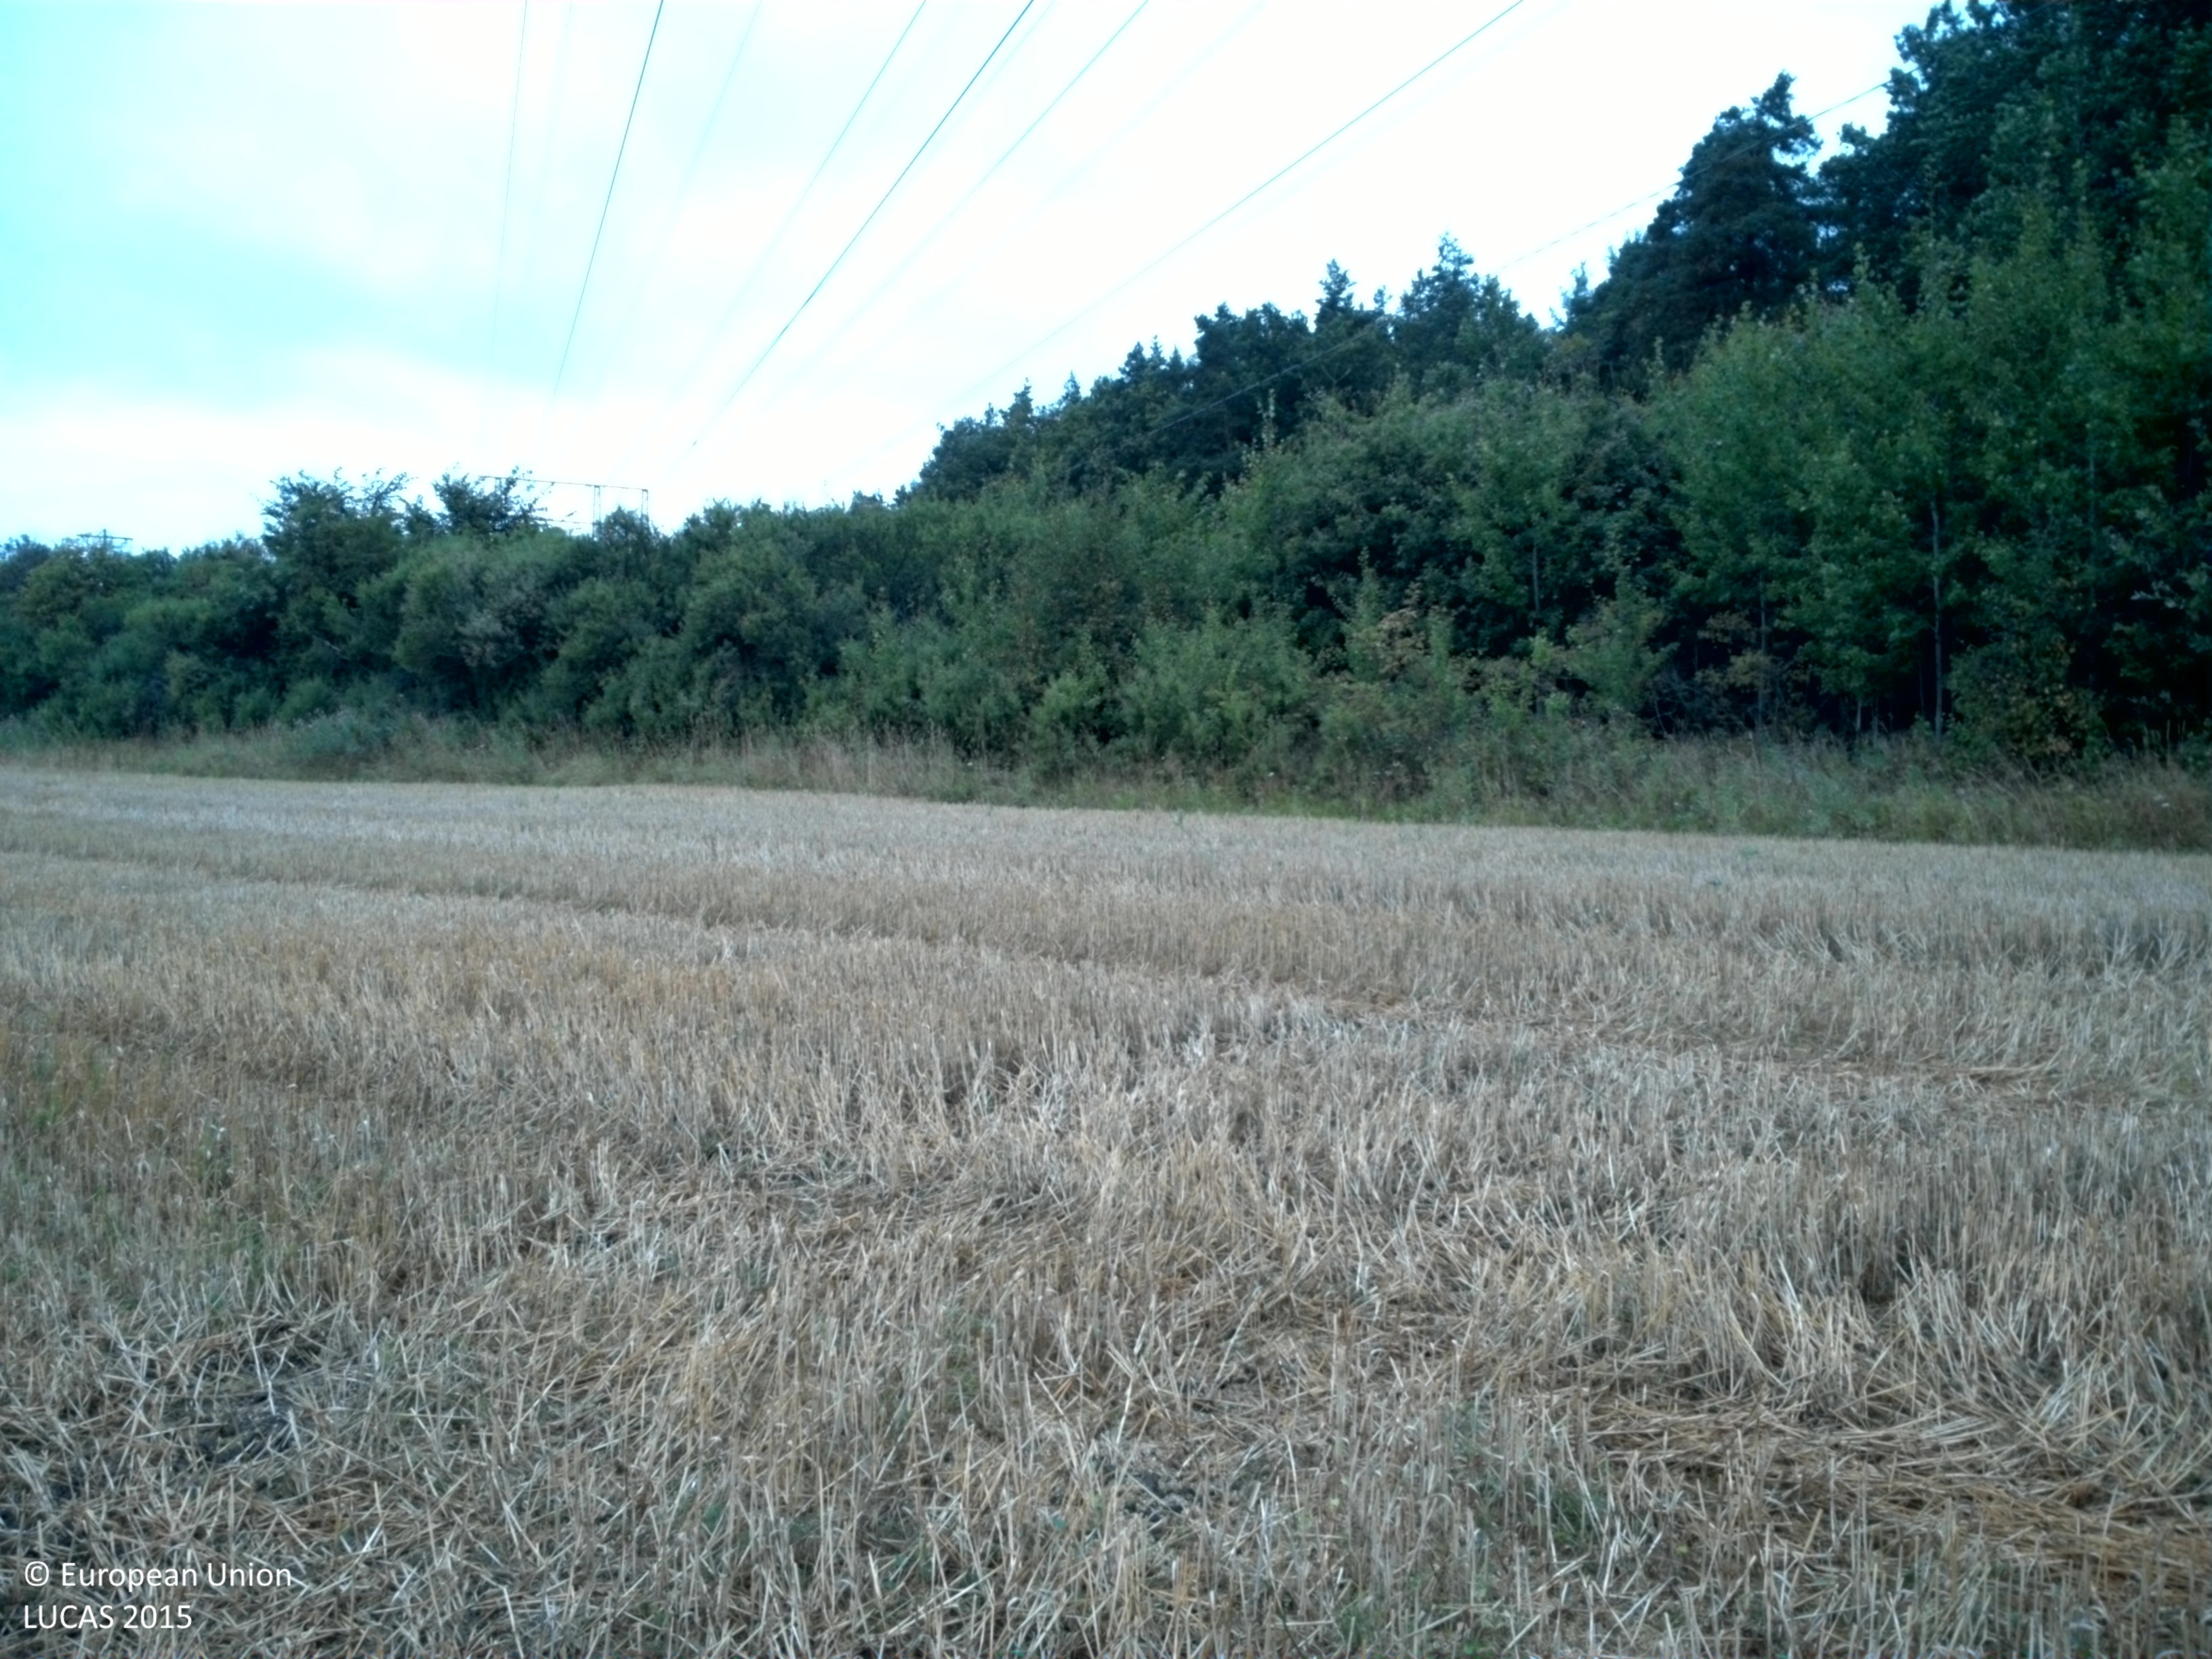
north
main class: Cropland
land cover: Common wheat
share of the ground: 10 - 25 %
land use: Agriculture (excluding fallow land and kitchen gardens)
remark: Harvested field
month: August
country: SE
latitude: 59.8998
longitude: 17.6631
